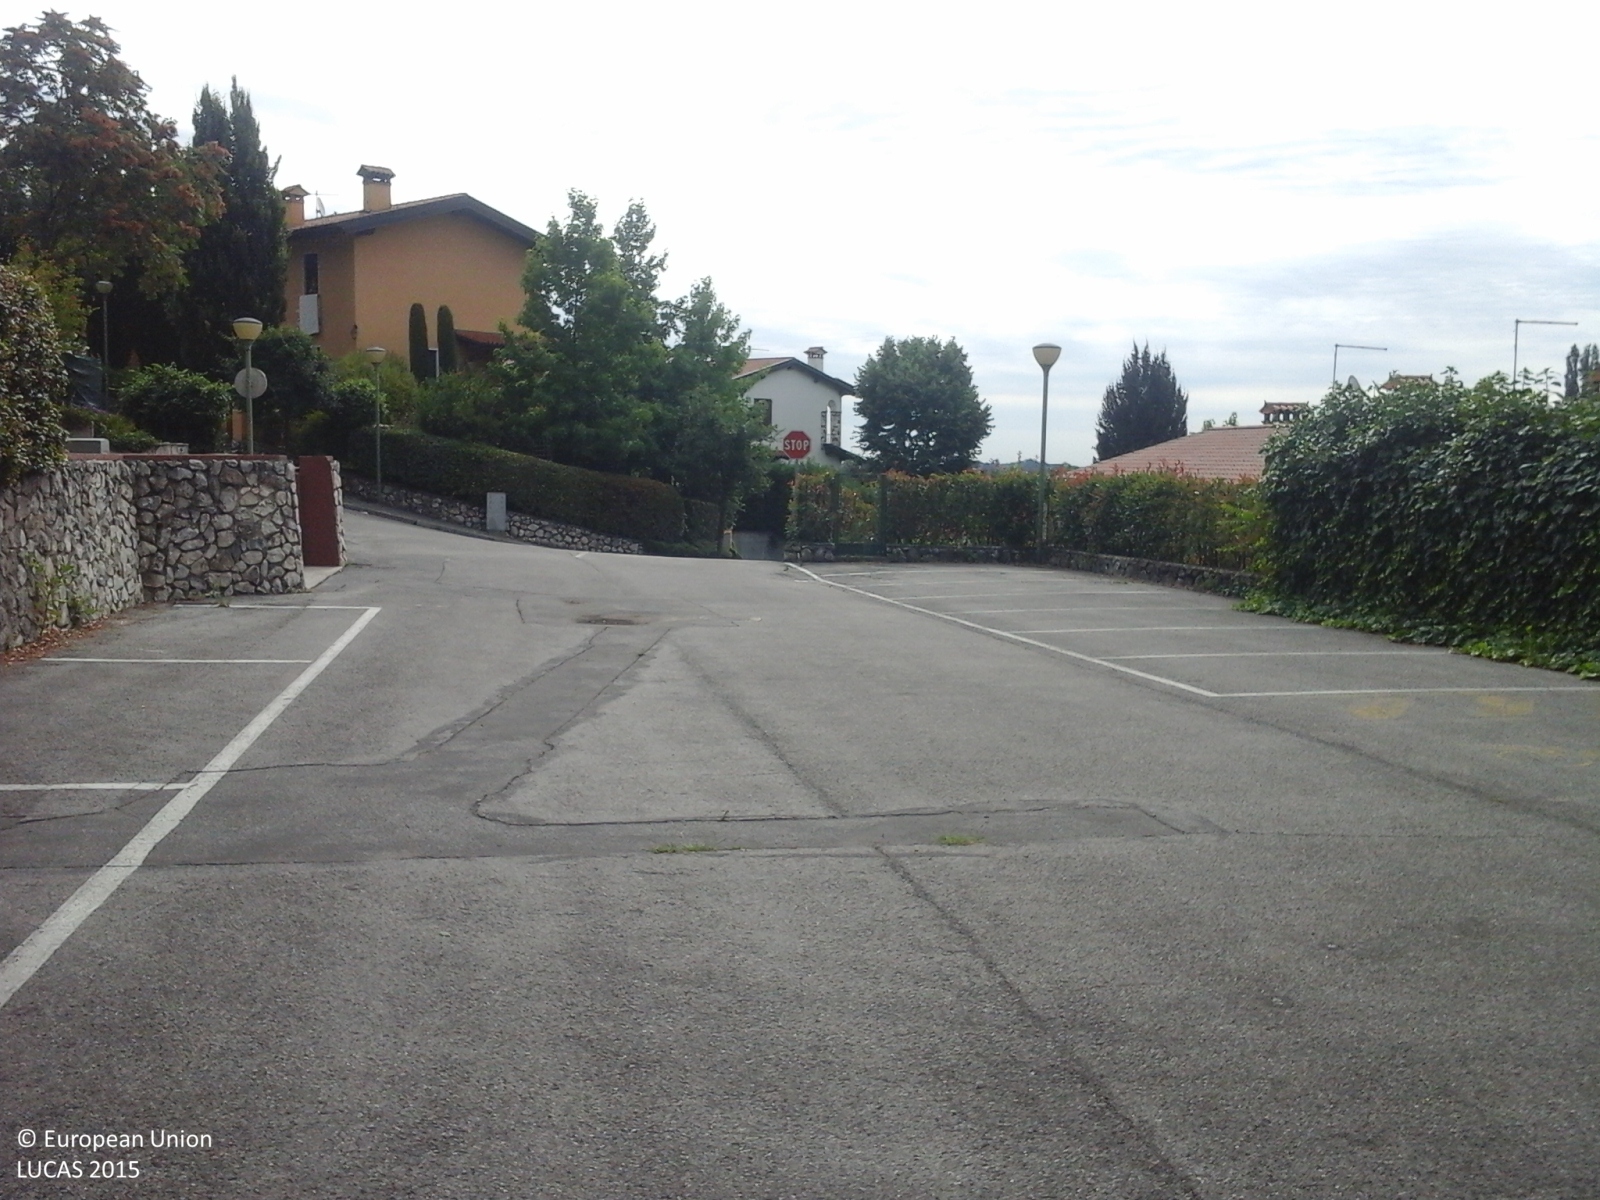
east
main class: Woodland
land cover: Broadleaved woodland
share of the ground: > 75 %
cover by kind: broadleaved forest trees 100 %
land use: Residential
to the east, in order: Broadleaved woodland; Artificial constructions in urban areas
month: June
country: IT
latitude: 45.7097
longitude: 11.5262
